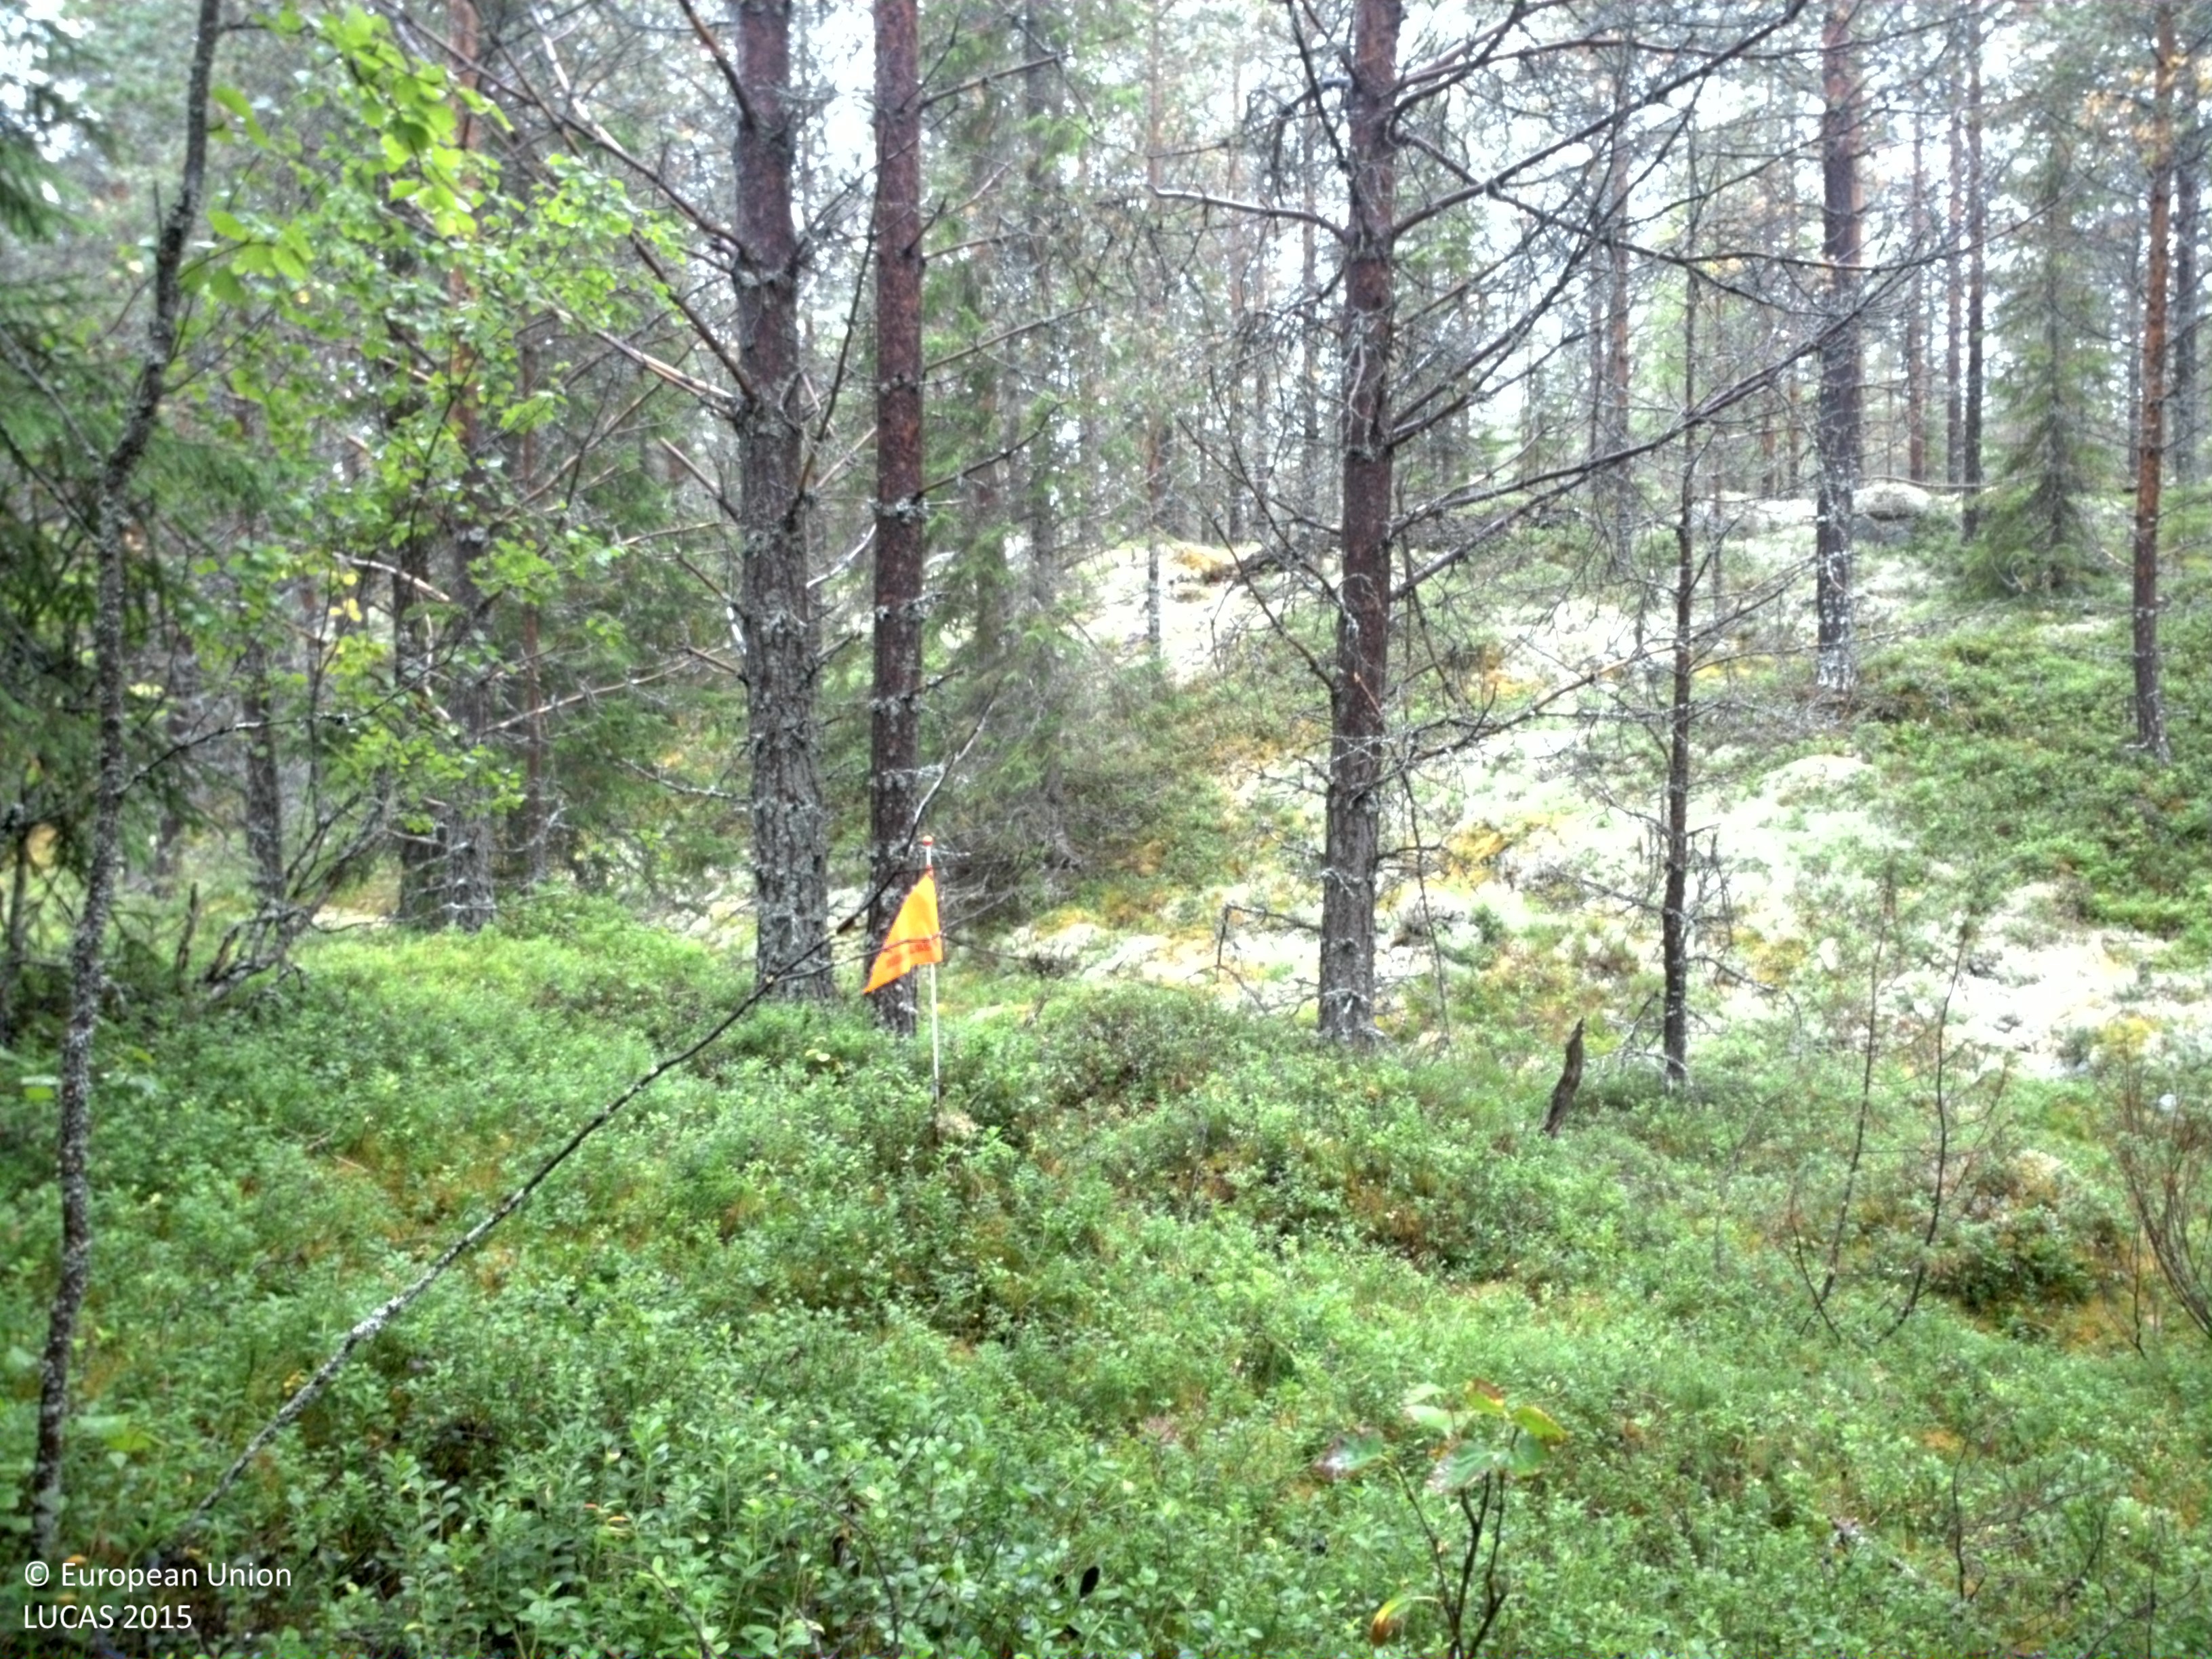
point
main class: Woodland
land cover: Pine dominated coniferous woodland
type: boreal forest
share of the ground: 50 - 75 %
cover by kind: coniferous forest trees 50 %, shrubs 25 %, lichens and mosses 15 %, broadleaved forest trees 10 %
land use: Forestry
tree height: > 5 m
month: August
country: SE
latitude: 61.7884
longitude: 15.0084
